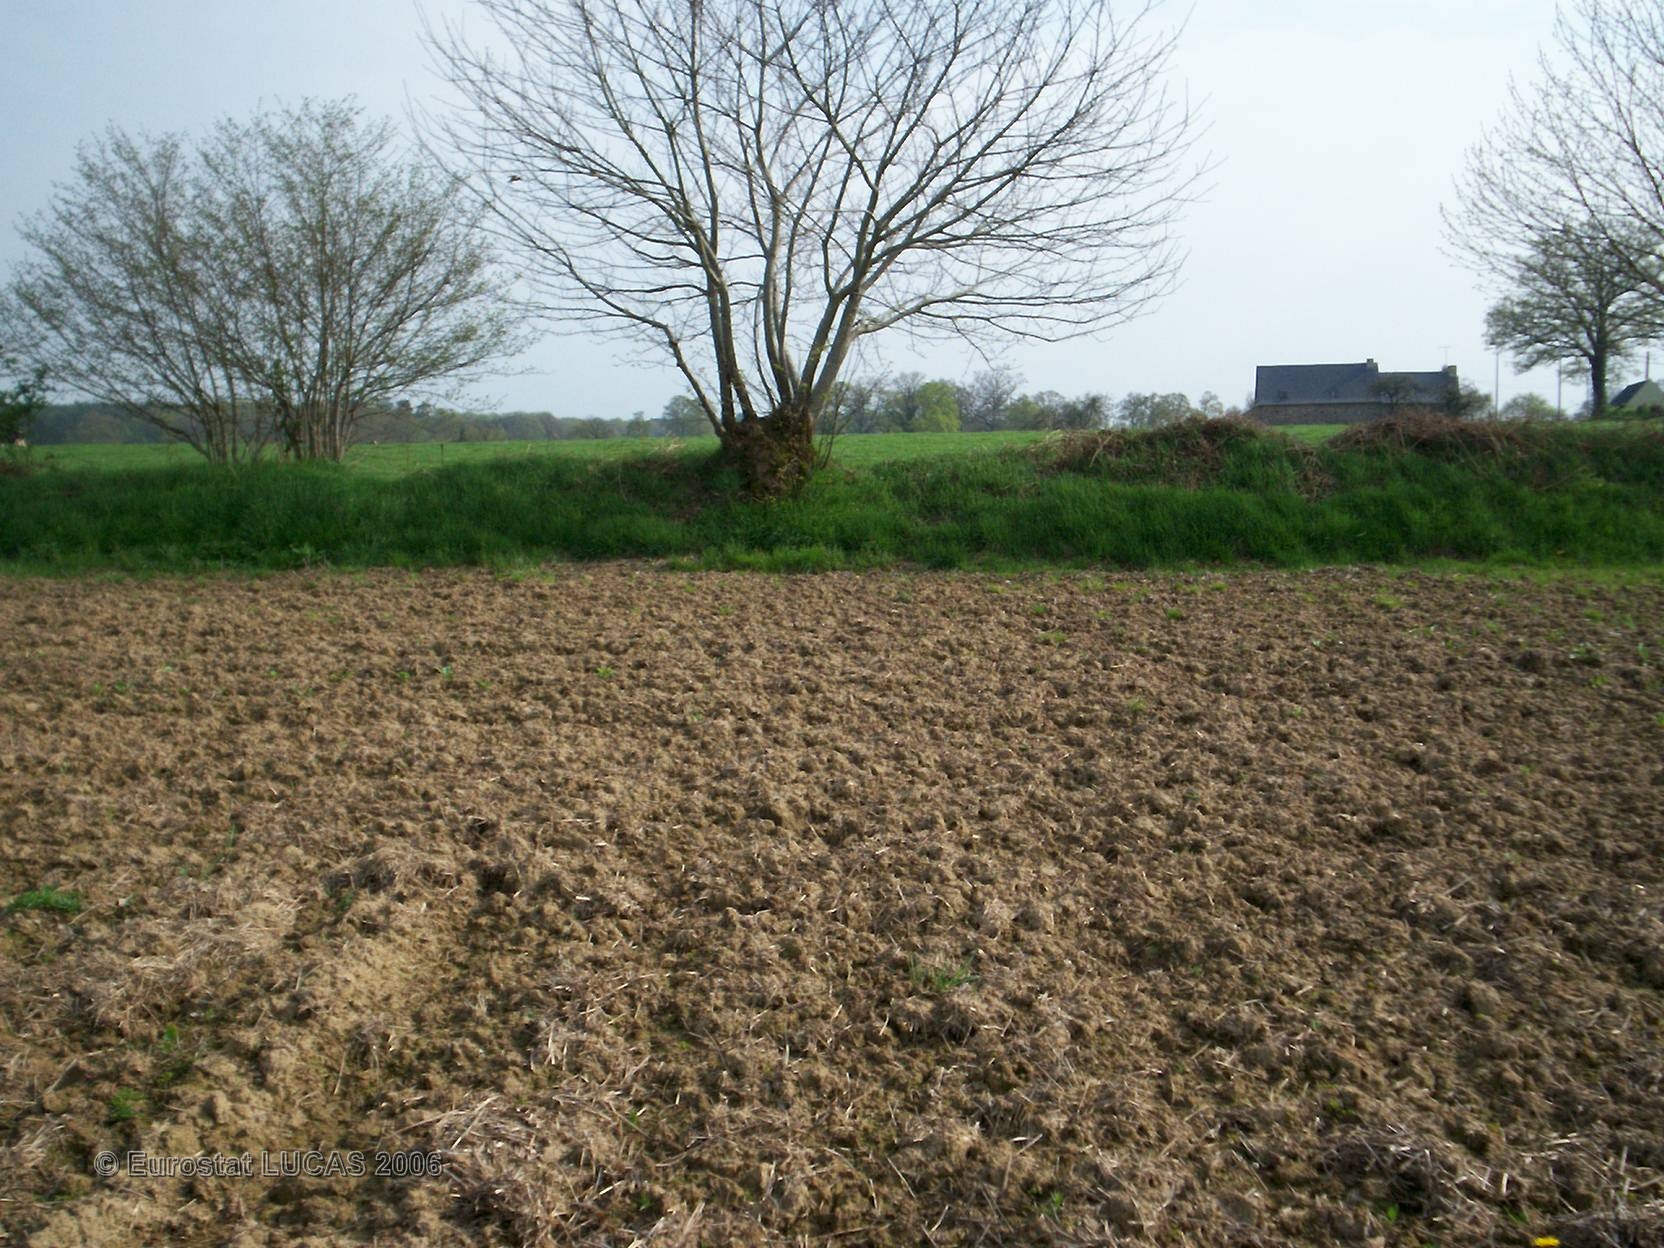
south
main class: Cropland
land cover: Maize
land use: Agriculture (excluding fallow land and kitchen gardens)
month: June
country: FR
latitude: 48.1621
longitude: -1.3508
